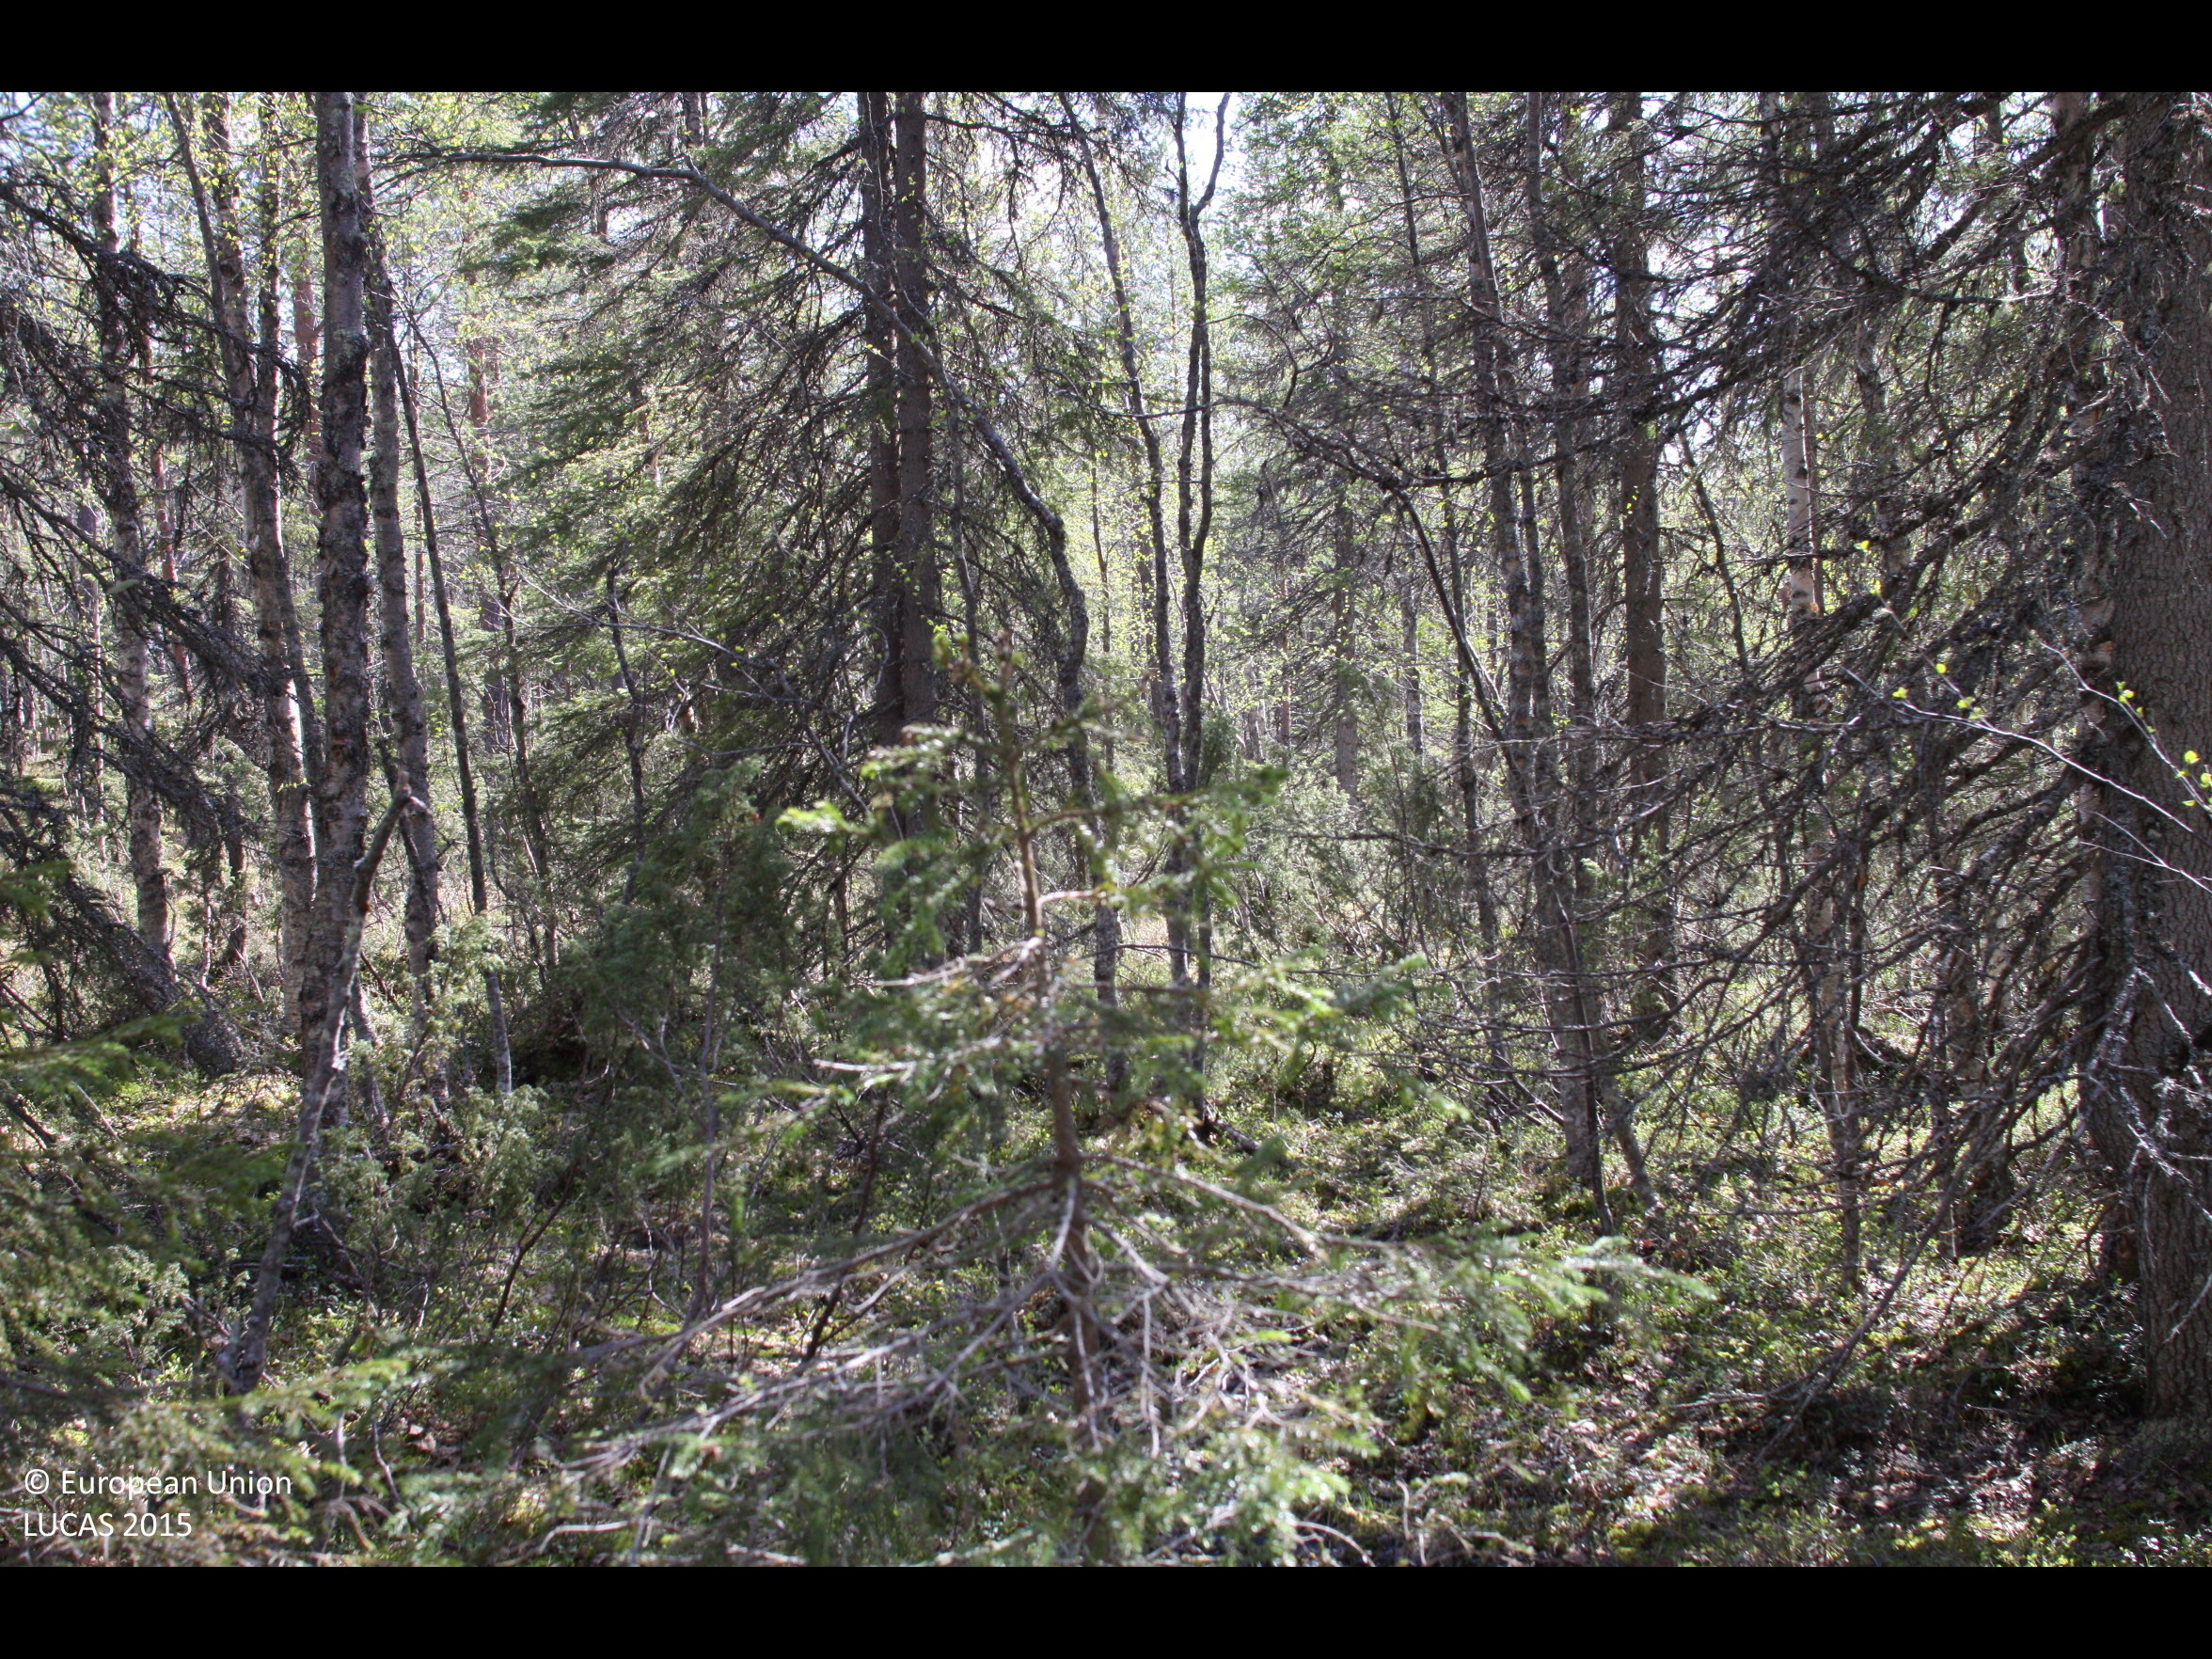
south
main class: Woodland
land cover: Spruce dominated mixed woodland
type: boreal forest
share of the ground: > 75 %
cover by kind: coniferous forest trees 40 %, broadleaved forest trees 40 %, shrubs 20 %
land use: Forestry
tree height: > 5 m
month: June
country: FI
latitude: 66.2062
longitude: 27.6949
